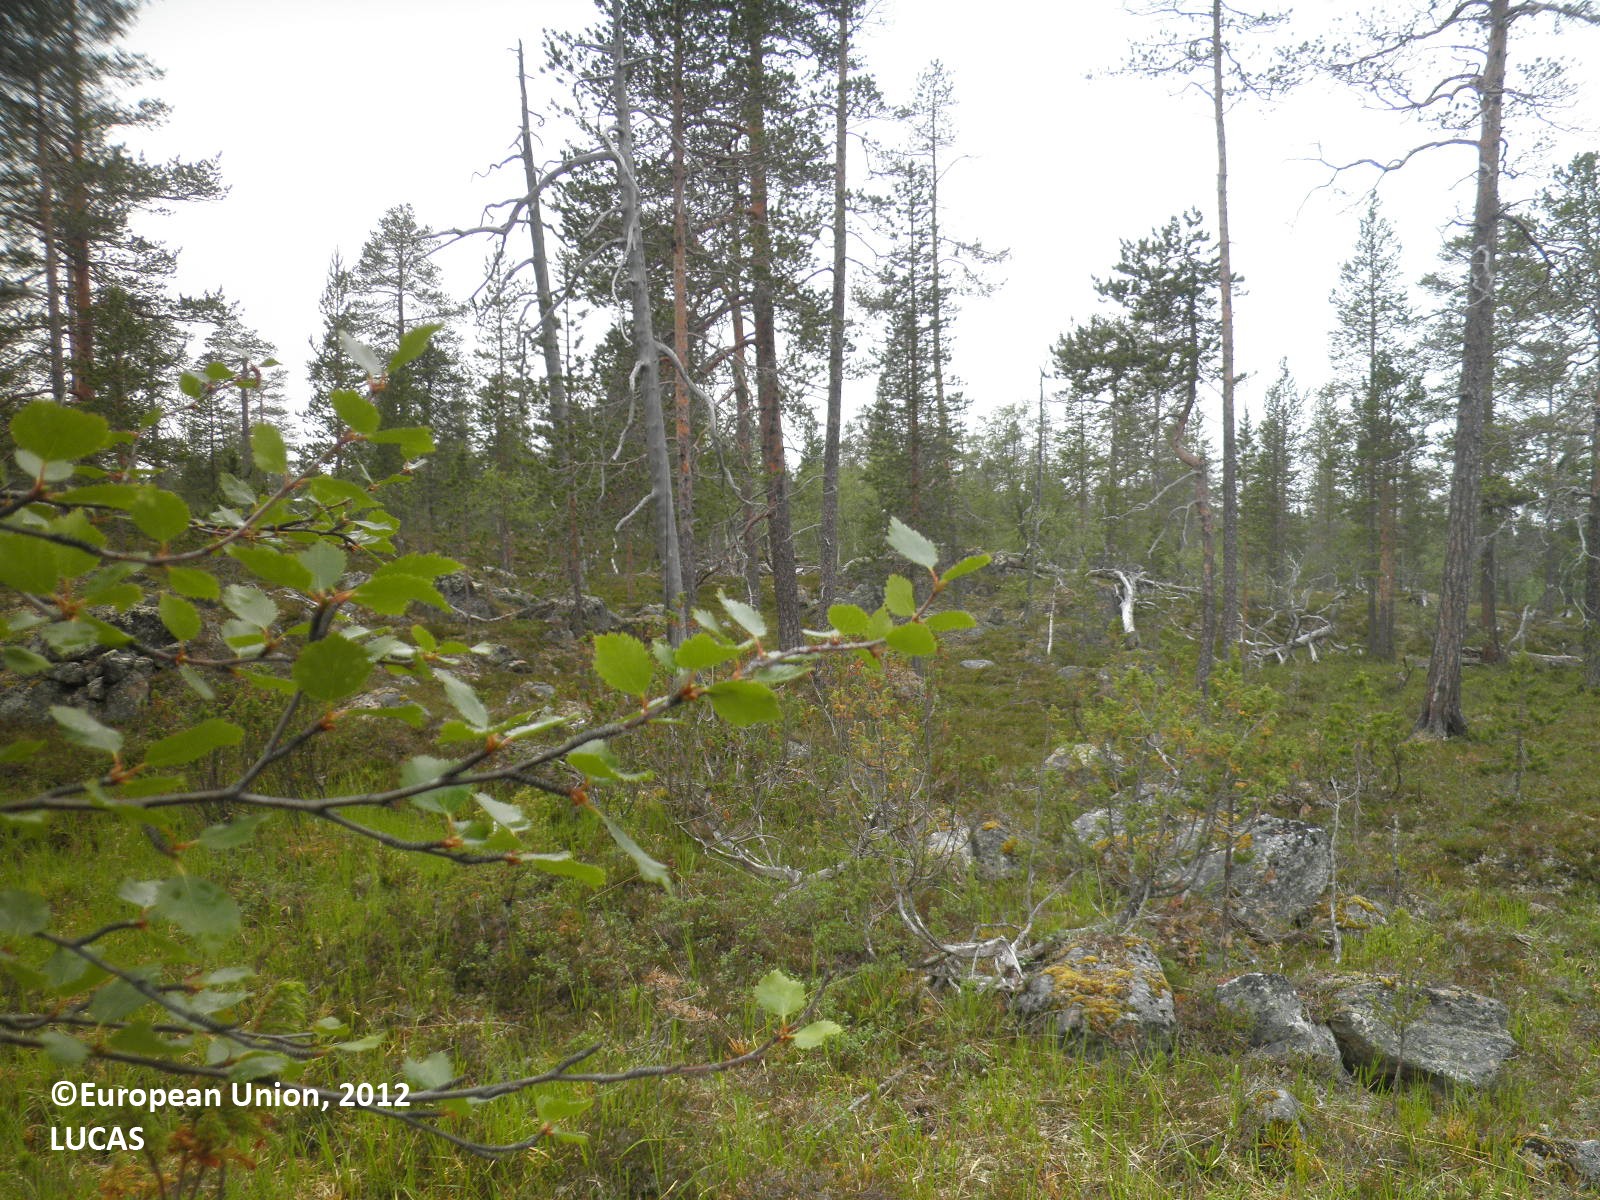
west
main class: Woodland
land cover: Pine dominated mixed woodland
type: boreal forest
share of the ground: 10 - 25 %
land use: Semi-natural and natural areas not in use
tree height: > 5 m
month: July
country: FI
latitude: 68.5411
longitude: 27.7463
